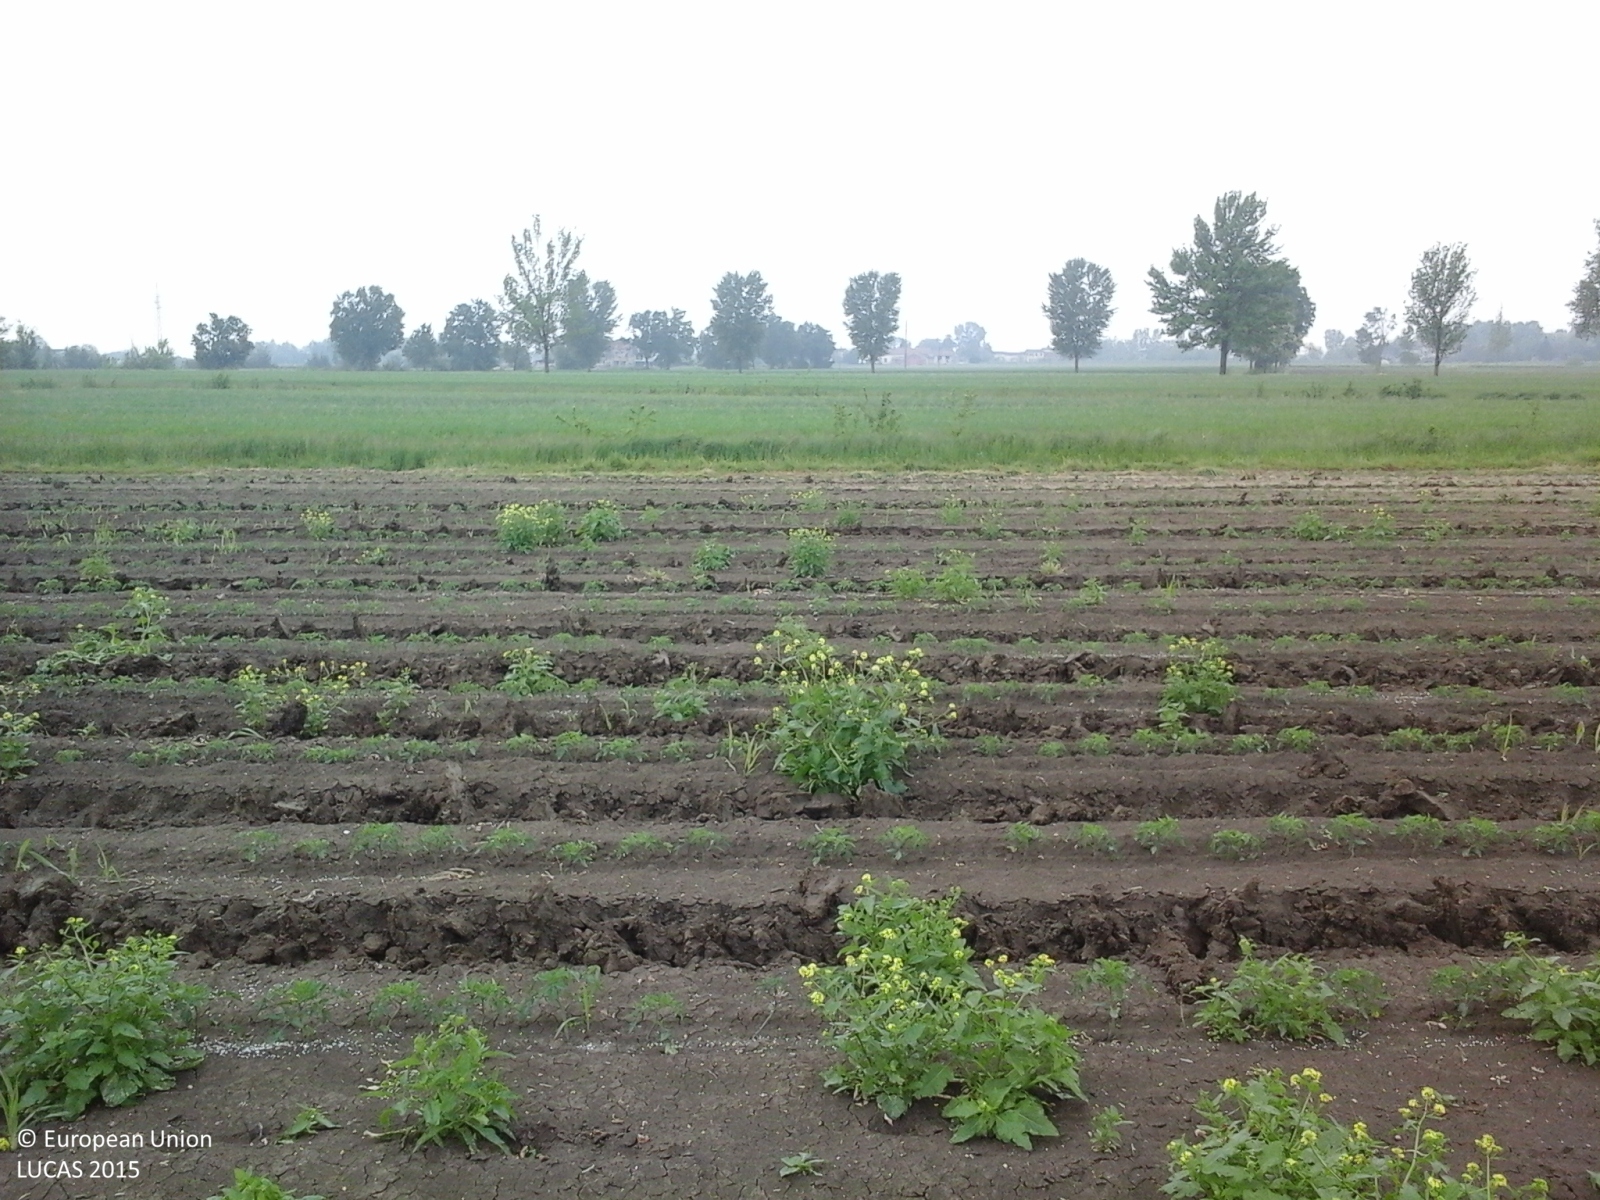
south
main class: Cropland
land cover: Tomatoes
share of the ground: 10 - 25 %
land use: Agriculture (excluding fallow land and kitchen gardens)
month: May
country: IT
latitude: 45.0342
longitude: 10.5701
